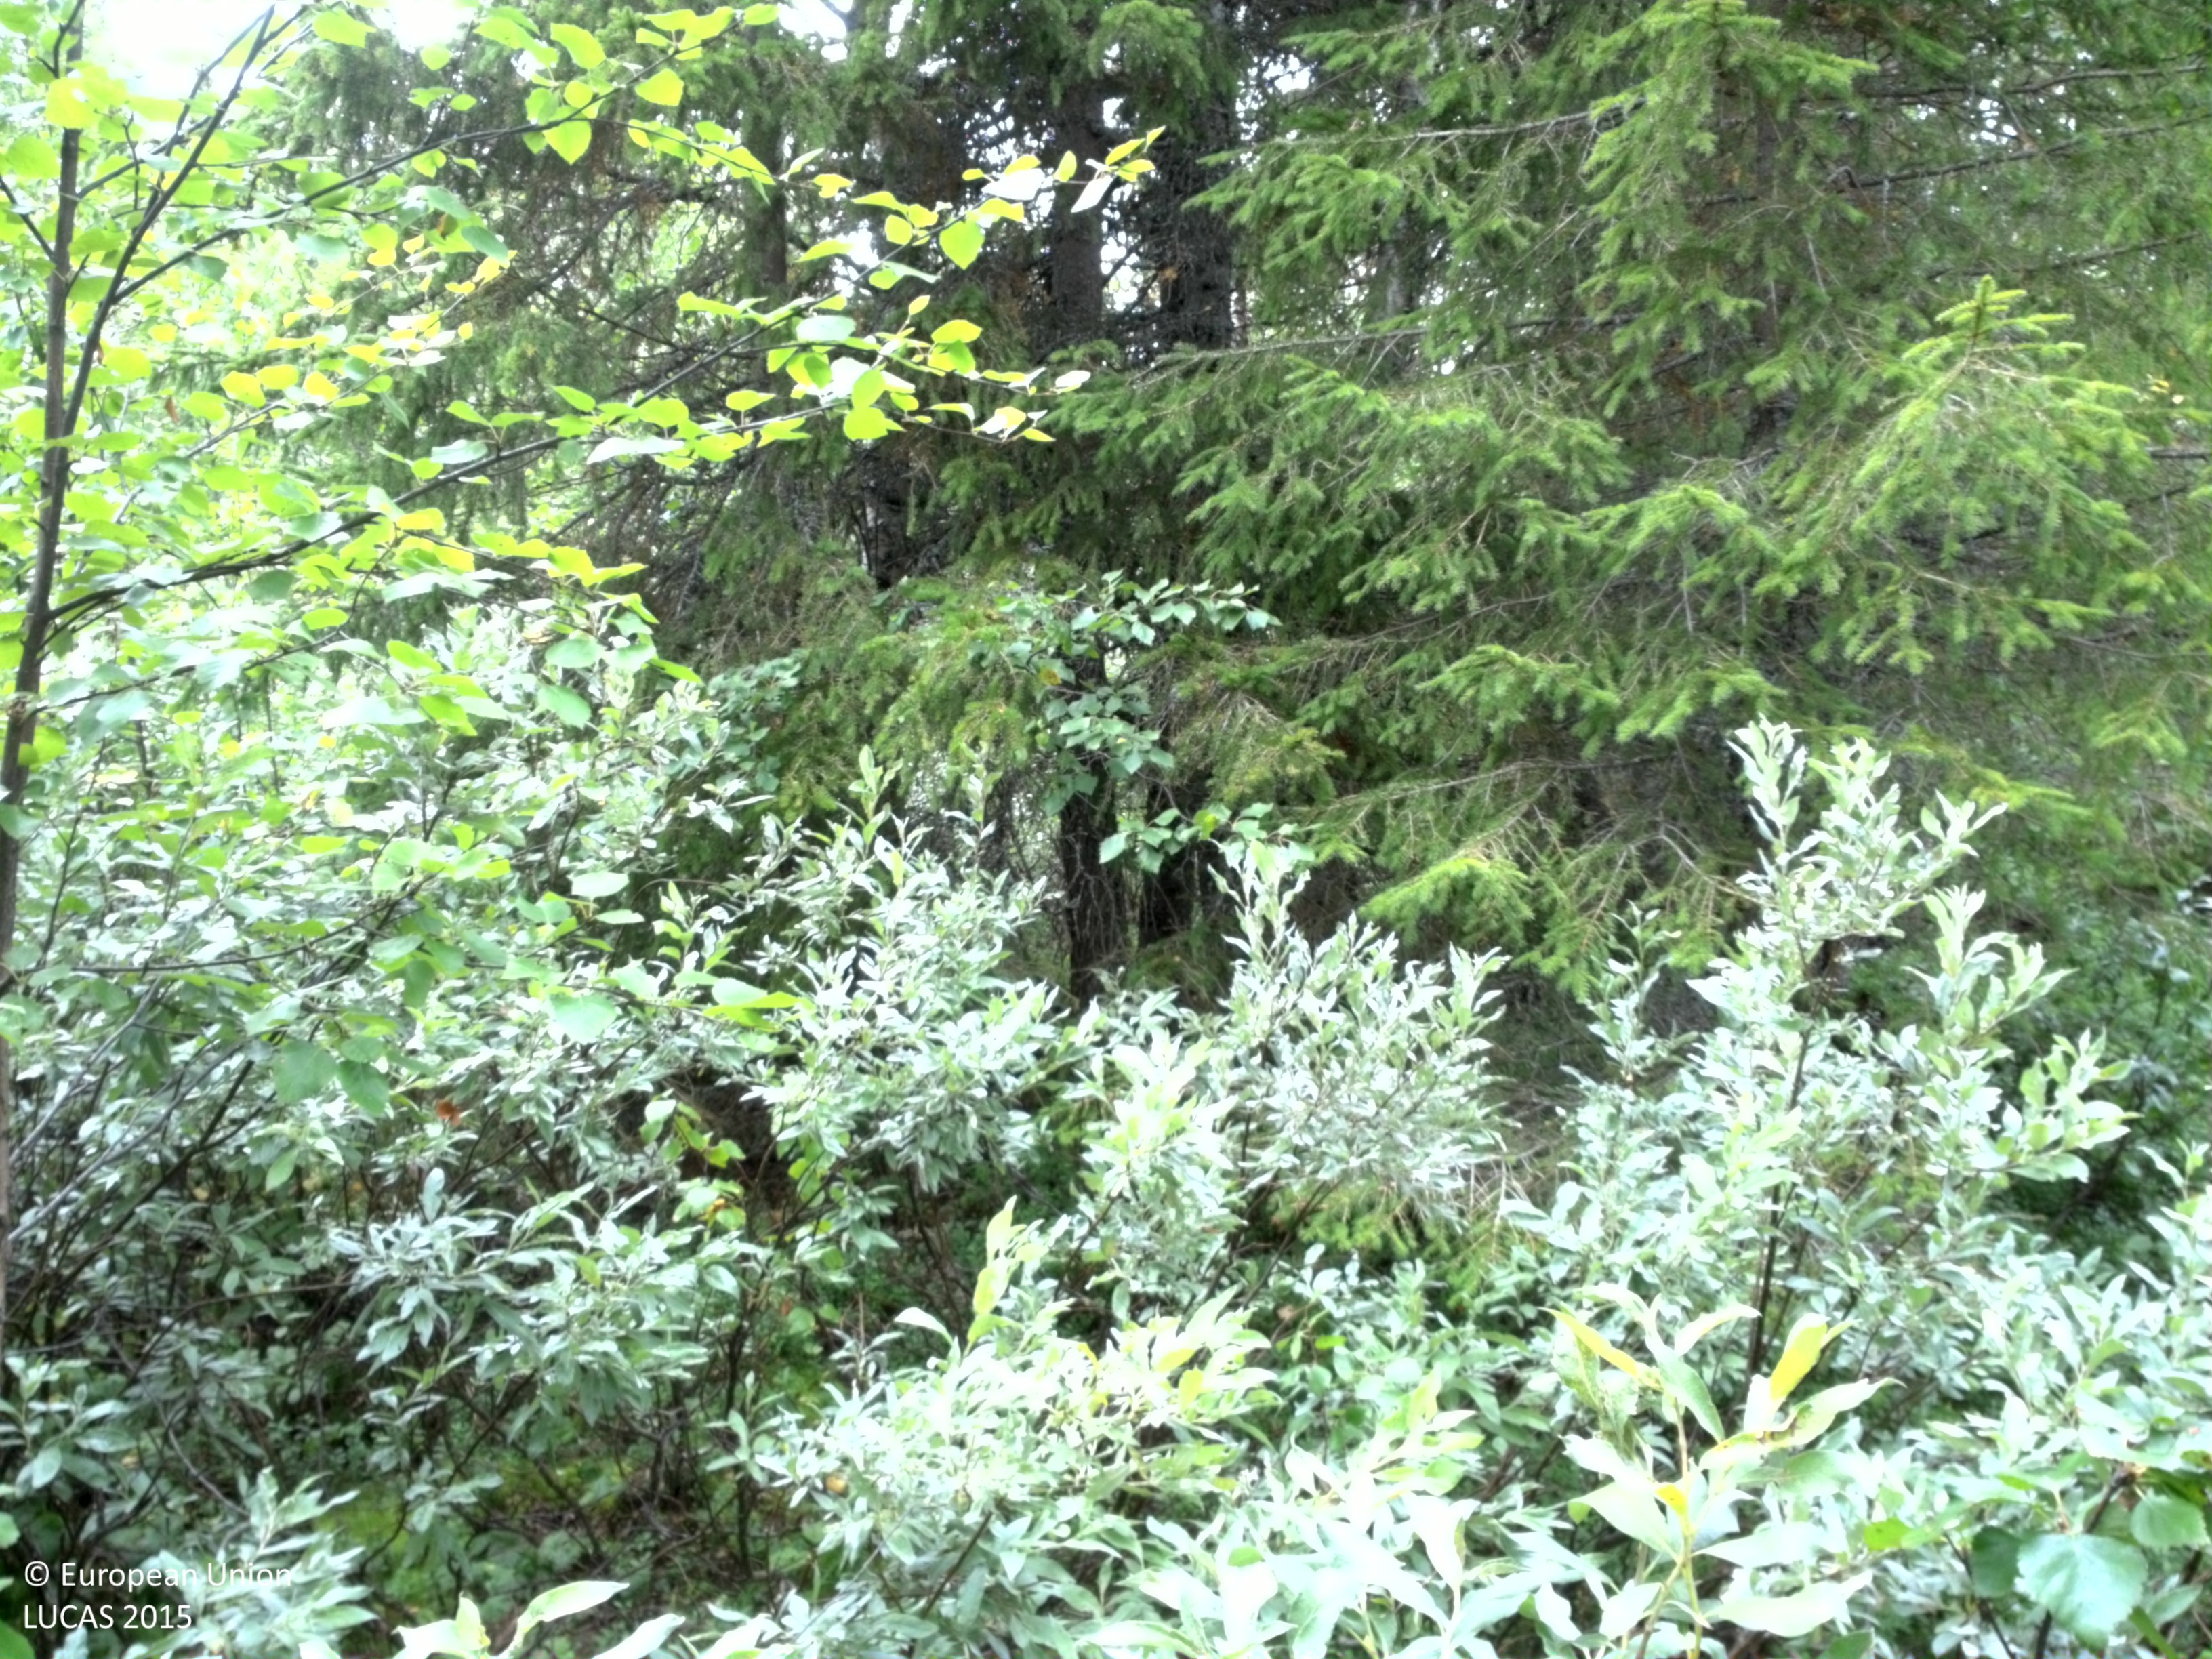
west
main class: Woodland
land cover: Spruce dominated mixed woodland
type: boreal forest
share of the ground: 50 - 75 %
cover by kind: shrubs 45 %, broadleaved forest trees 30 %, coniferous forest trees 20 %, lichens and mosses 5 %
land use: Forestry
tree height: > 5 m
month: August
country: SE
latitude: 64.9219
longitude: 16.8368
